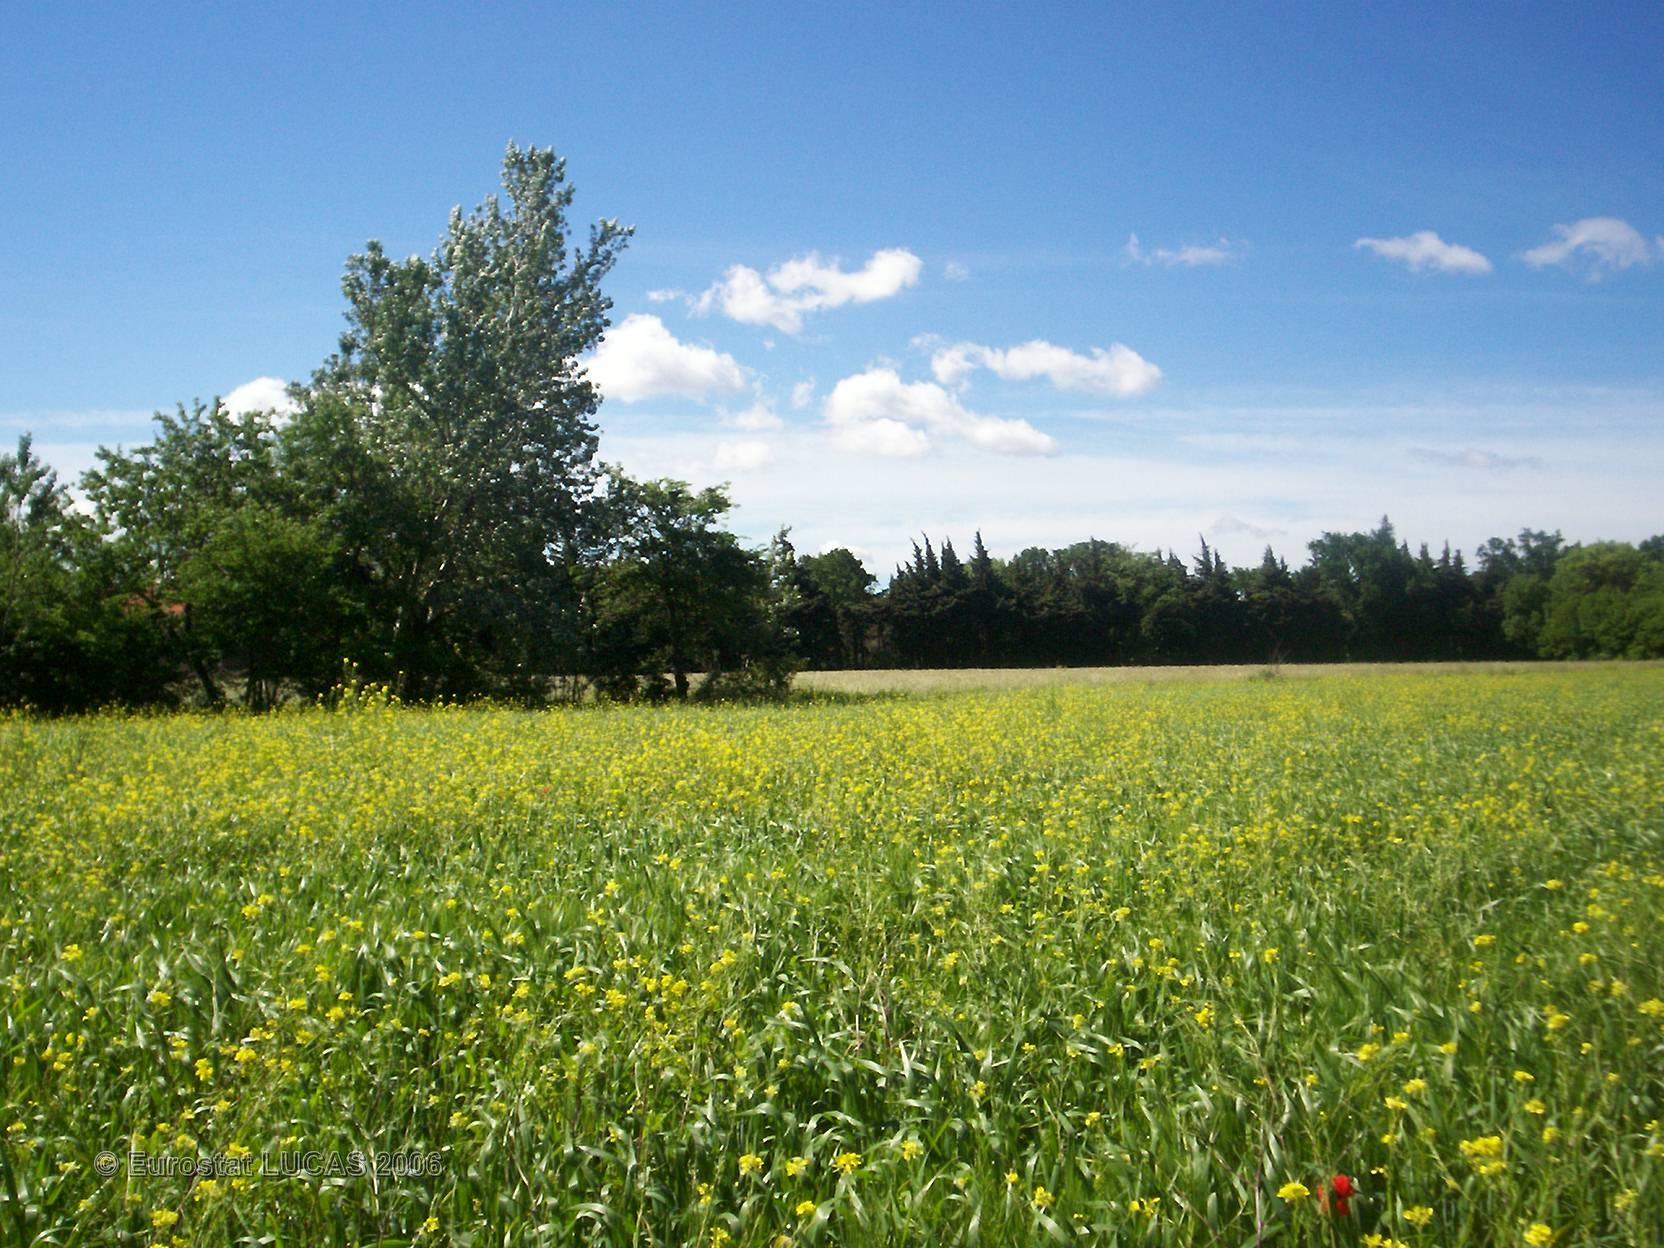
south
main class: Cropland
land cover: Durum wheat
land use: Agriculture (excluding fallow land and kitchen gardens)
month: May
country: FR
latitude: 43.9907
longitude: 4.9087
